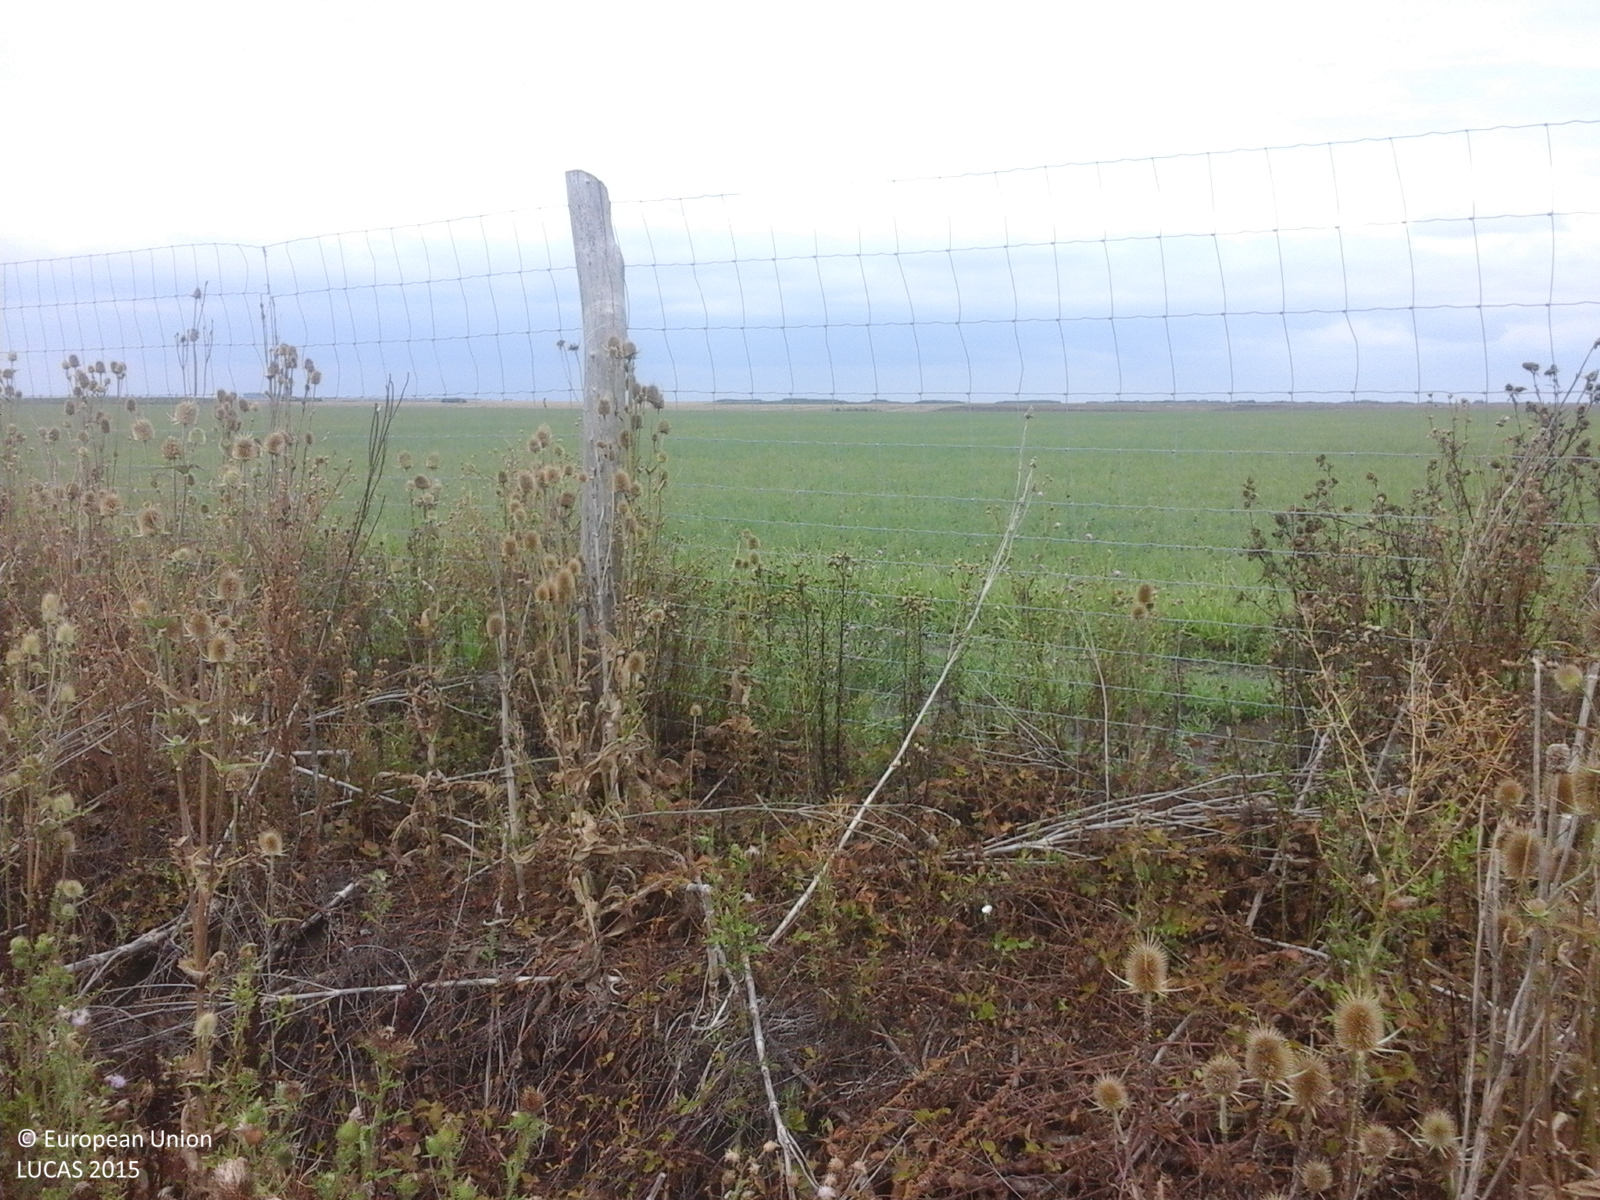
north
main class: Grassland
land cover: Grassland without tree/shrub cover
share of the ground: > 75 %
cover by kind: herbaceous plants 100 %
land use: Agriculture (excluding fallow land and kitchen gardens)
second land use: Sport
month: August
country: RO
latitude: 45.4571
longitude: 21.3217
